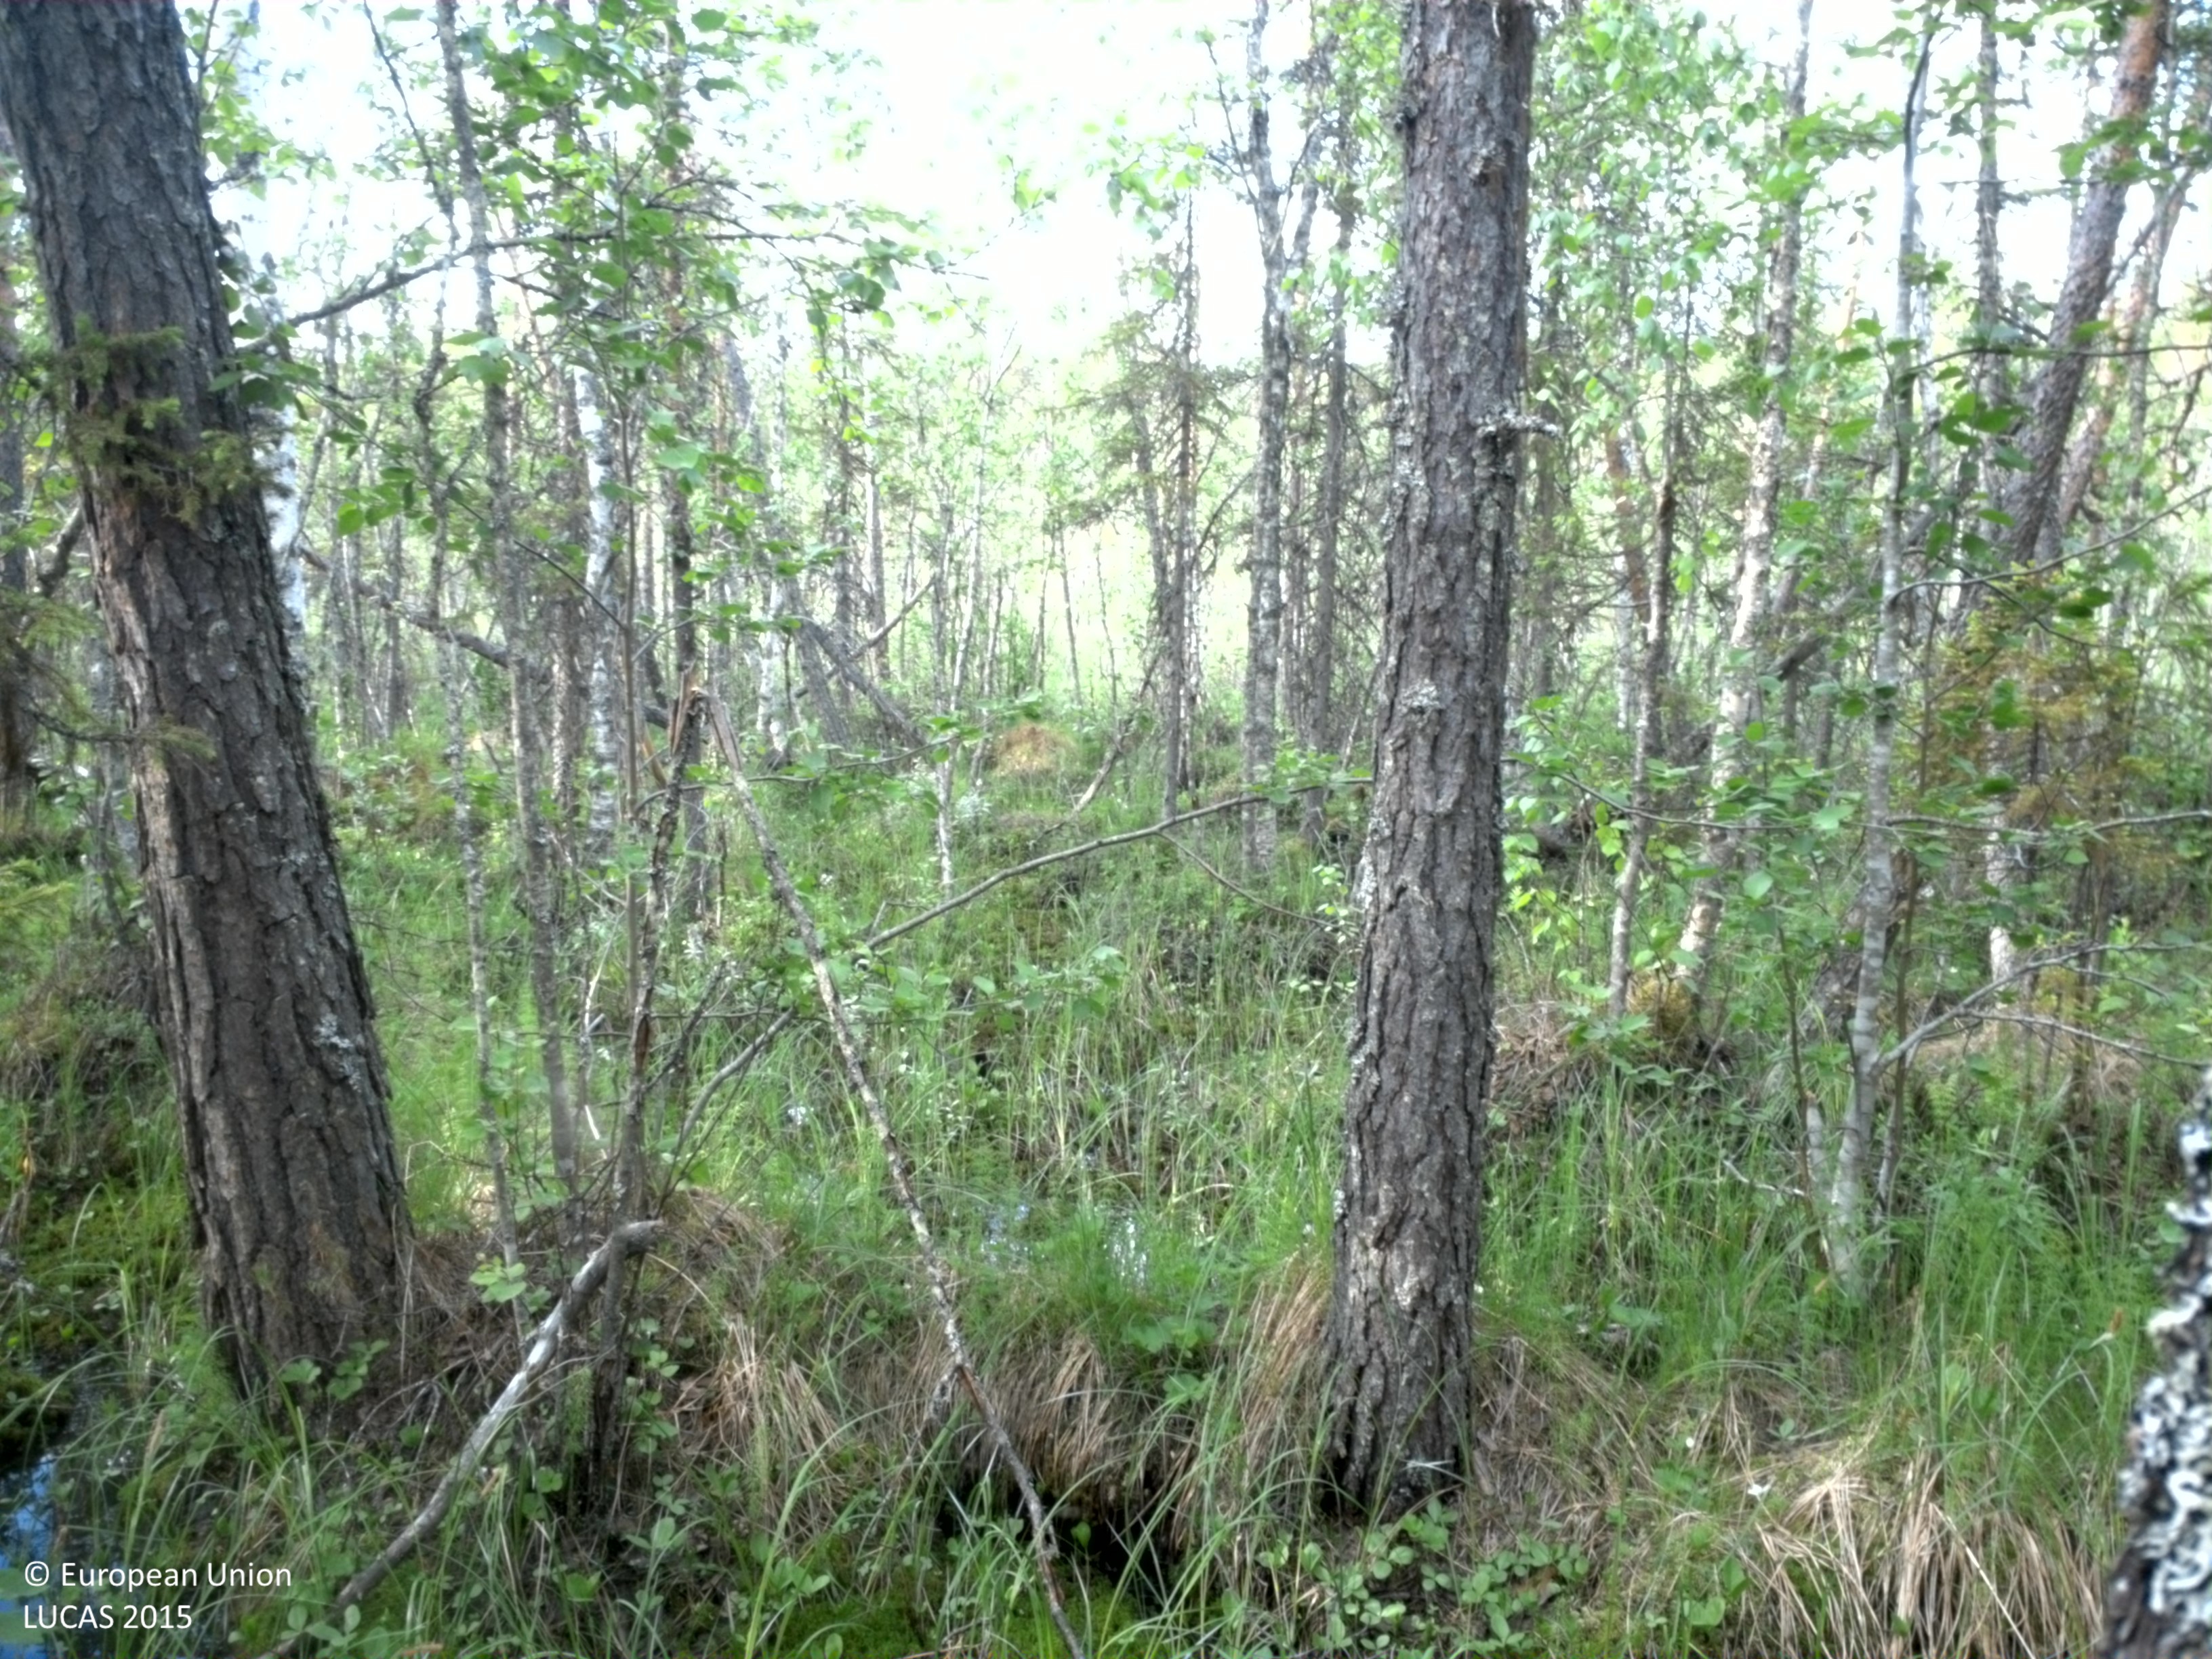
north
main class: Woodland
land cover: Pine dominated mixed woodland
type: mire and swamp forests
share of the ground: 50 - 75 %
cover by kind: broadleaved forest trees 30 %, coniferous forest trees 25 %, herbaceous plants 20 %, lichens and mosses 10 %, shrubs 5 %
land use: Semi-natural and natural areas not in use
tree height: > 5 m
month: June
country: SE
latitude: 66.2488
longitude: 22.7719
